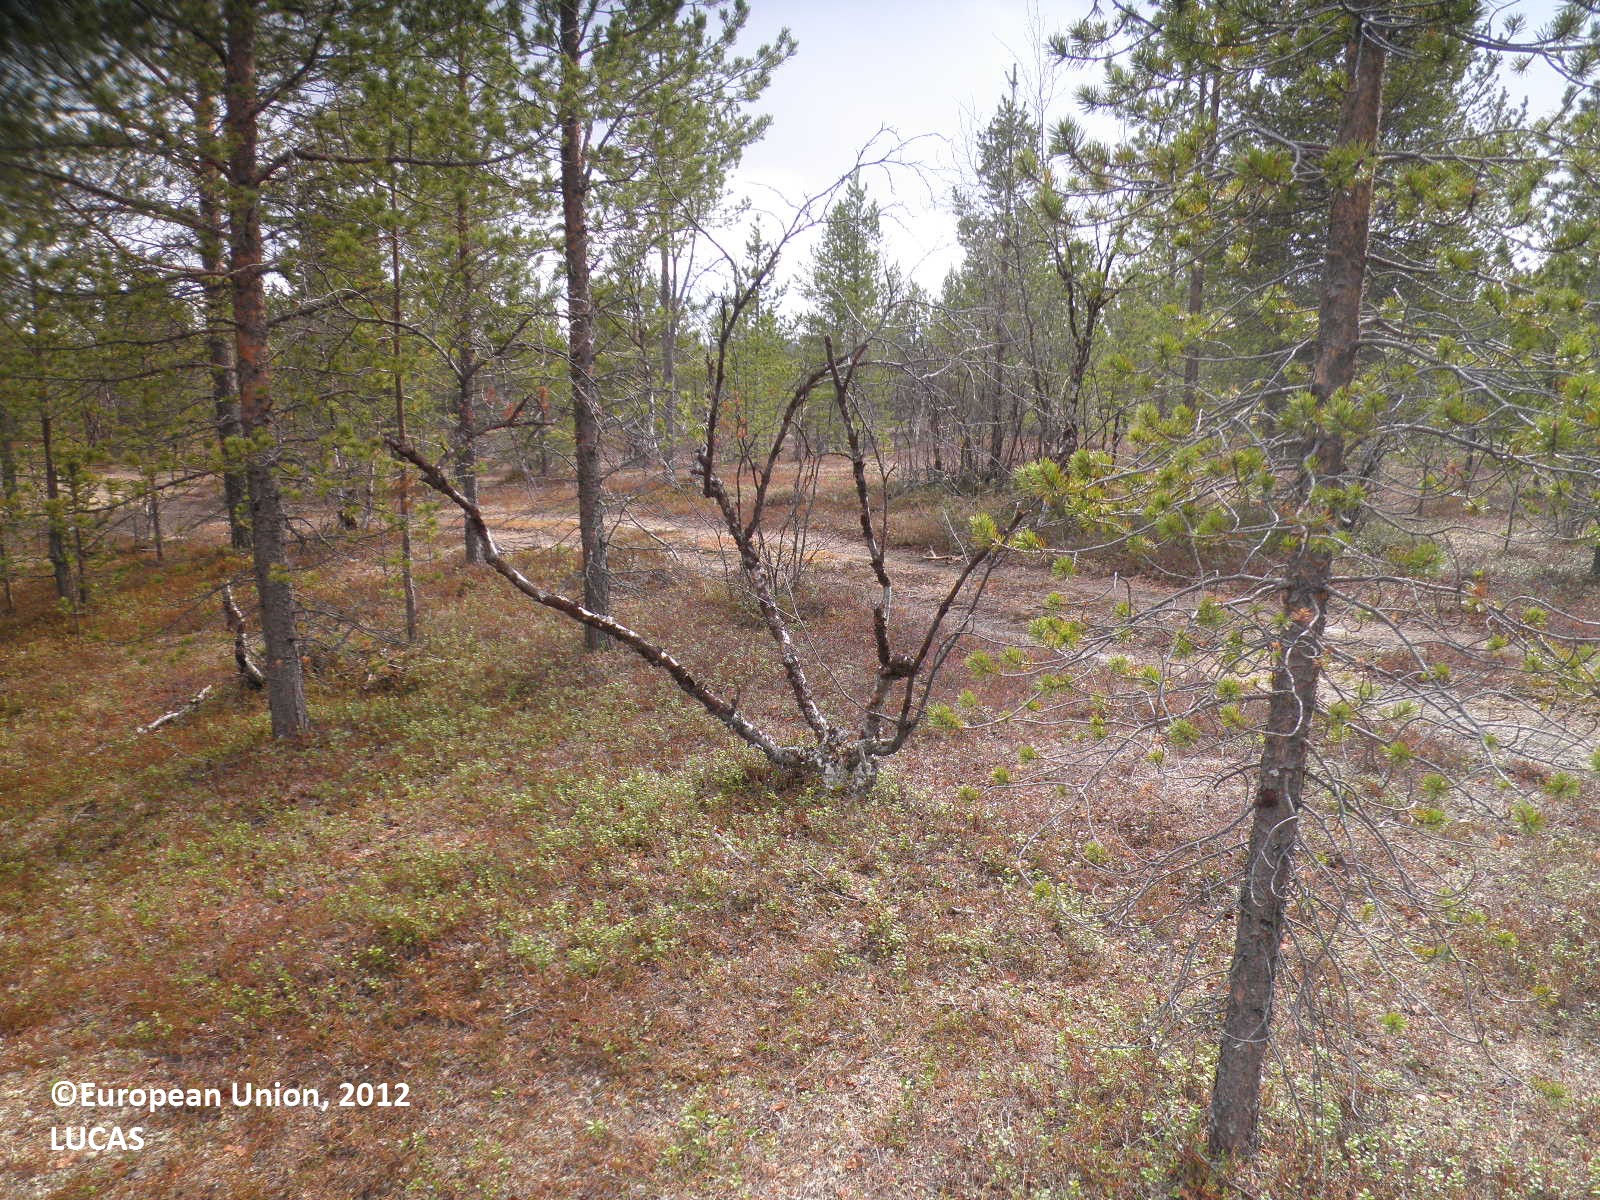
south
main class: Woodland
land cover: Pine dominated mixed woodland
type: boreal forest
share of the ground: > 75 %
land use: Forestry
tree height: > 5 m
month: May
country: FI
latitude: 69.2476
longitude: 26.8147
